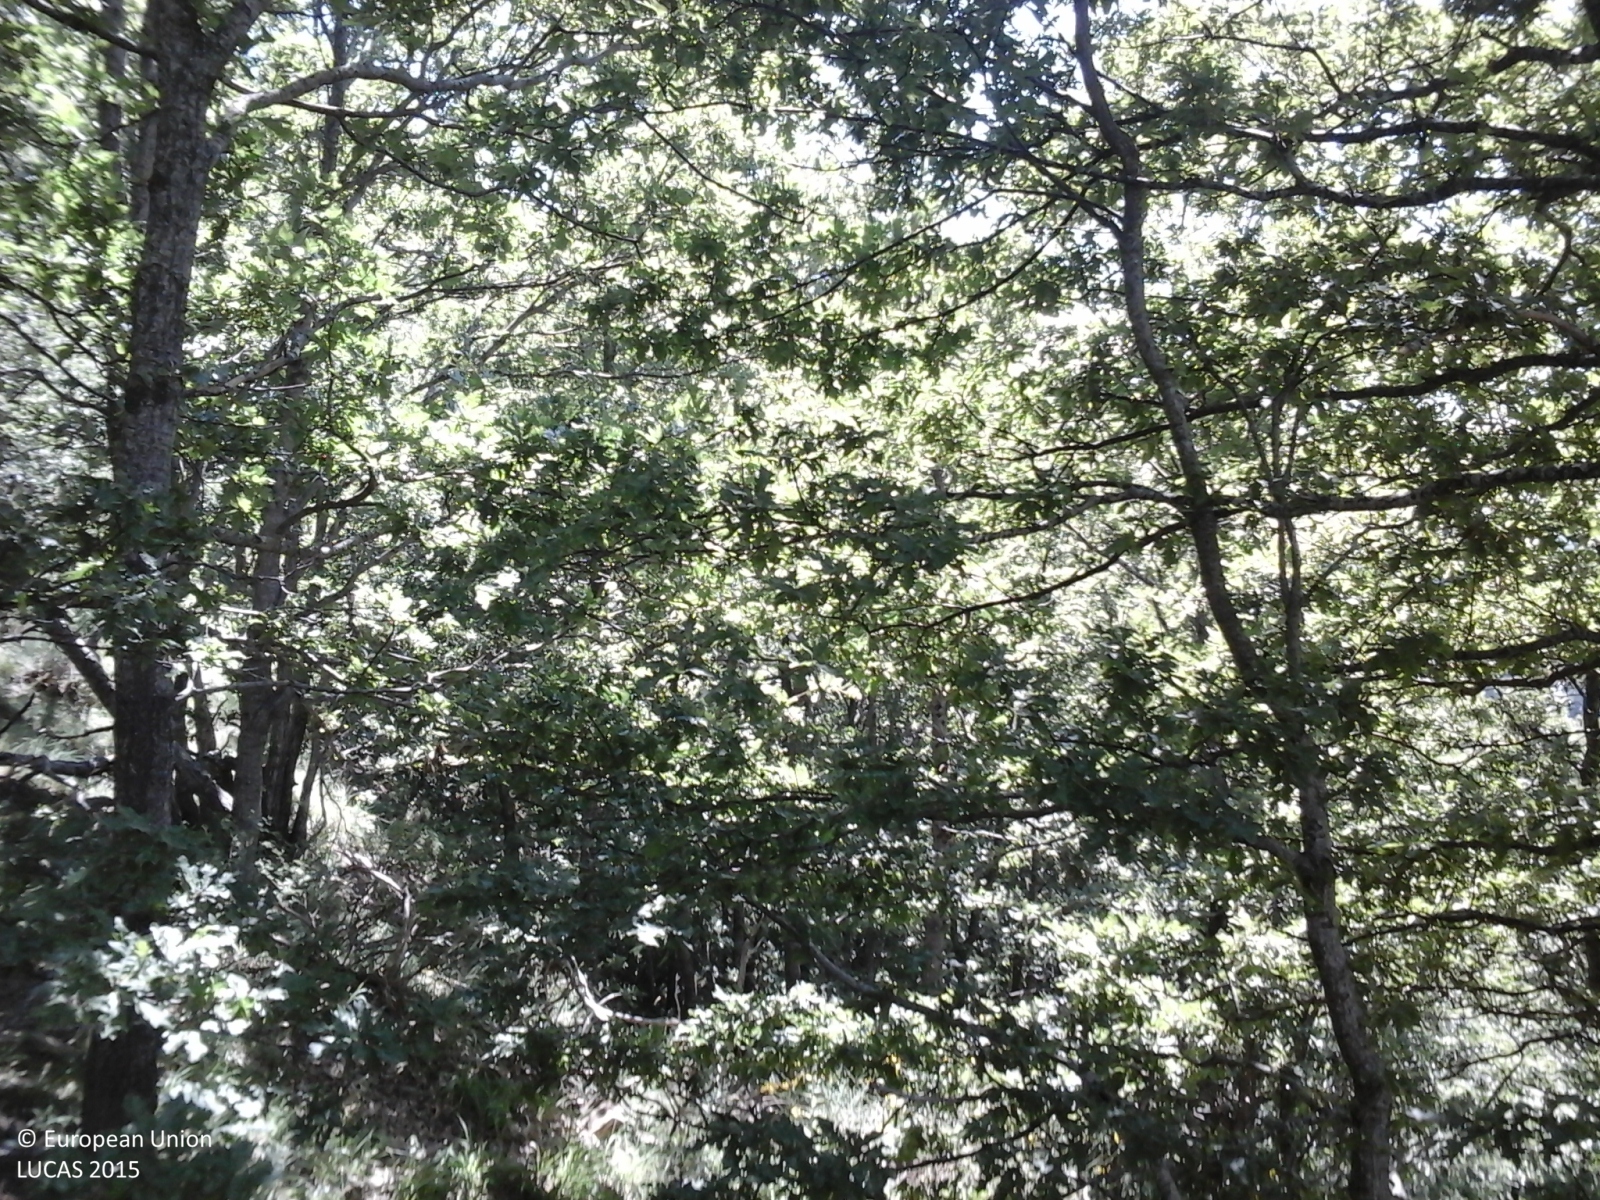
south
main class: Woodland
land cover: Broadleaved woodland
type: thermophilous deciduous forest
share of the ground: > 75 %
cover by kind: broadleaved forest trees 100 %
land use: Forestry
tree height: > 5 m
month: June
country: IT
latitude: 42.7629
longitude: 13.3018
